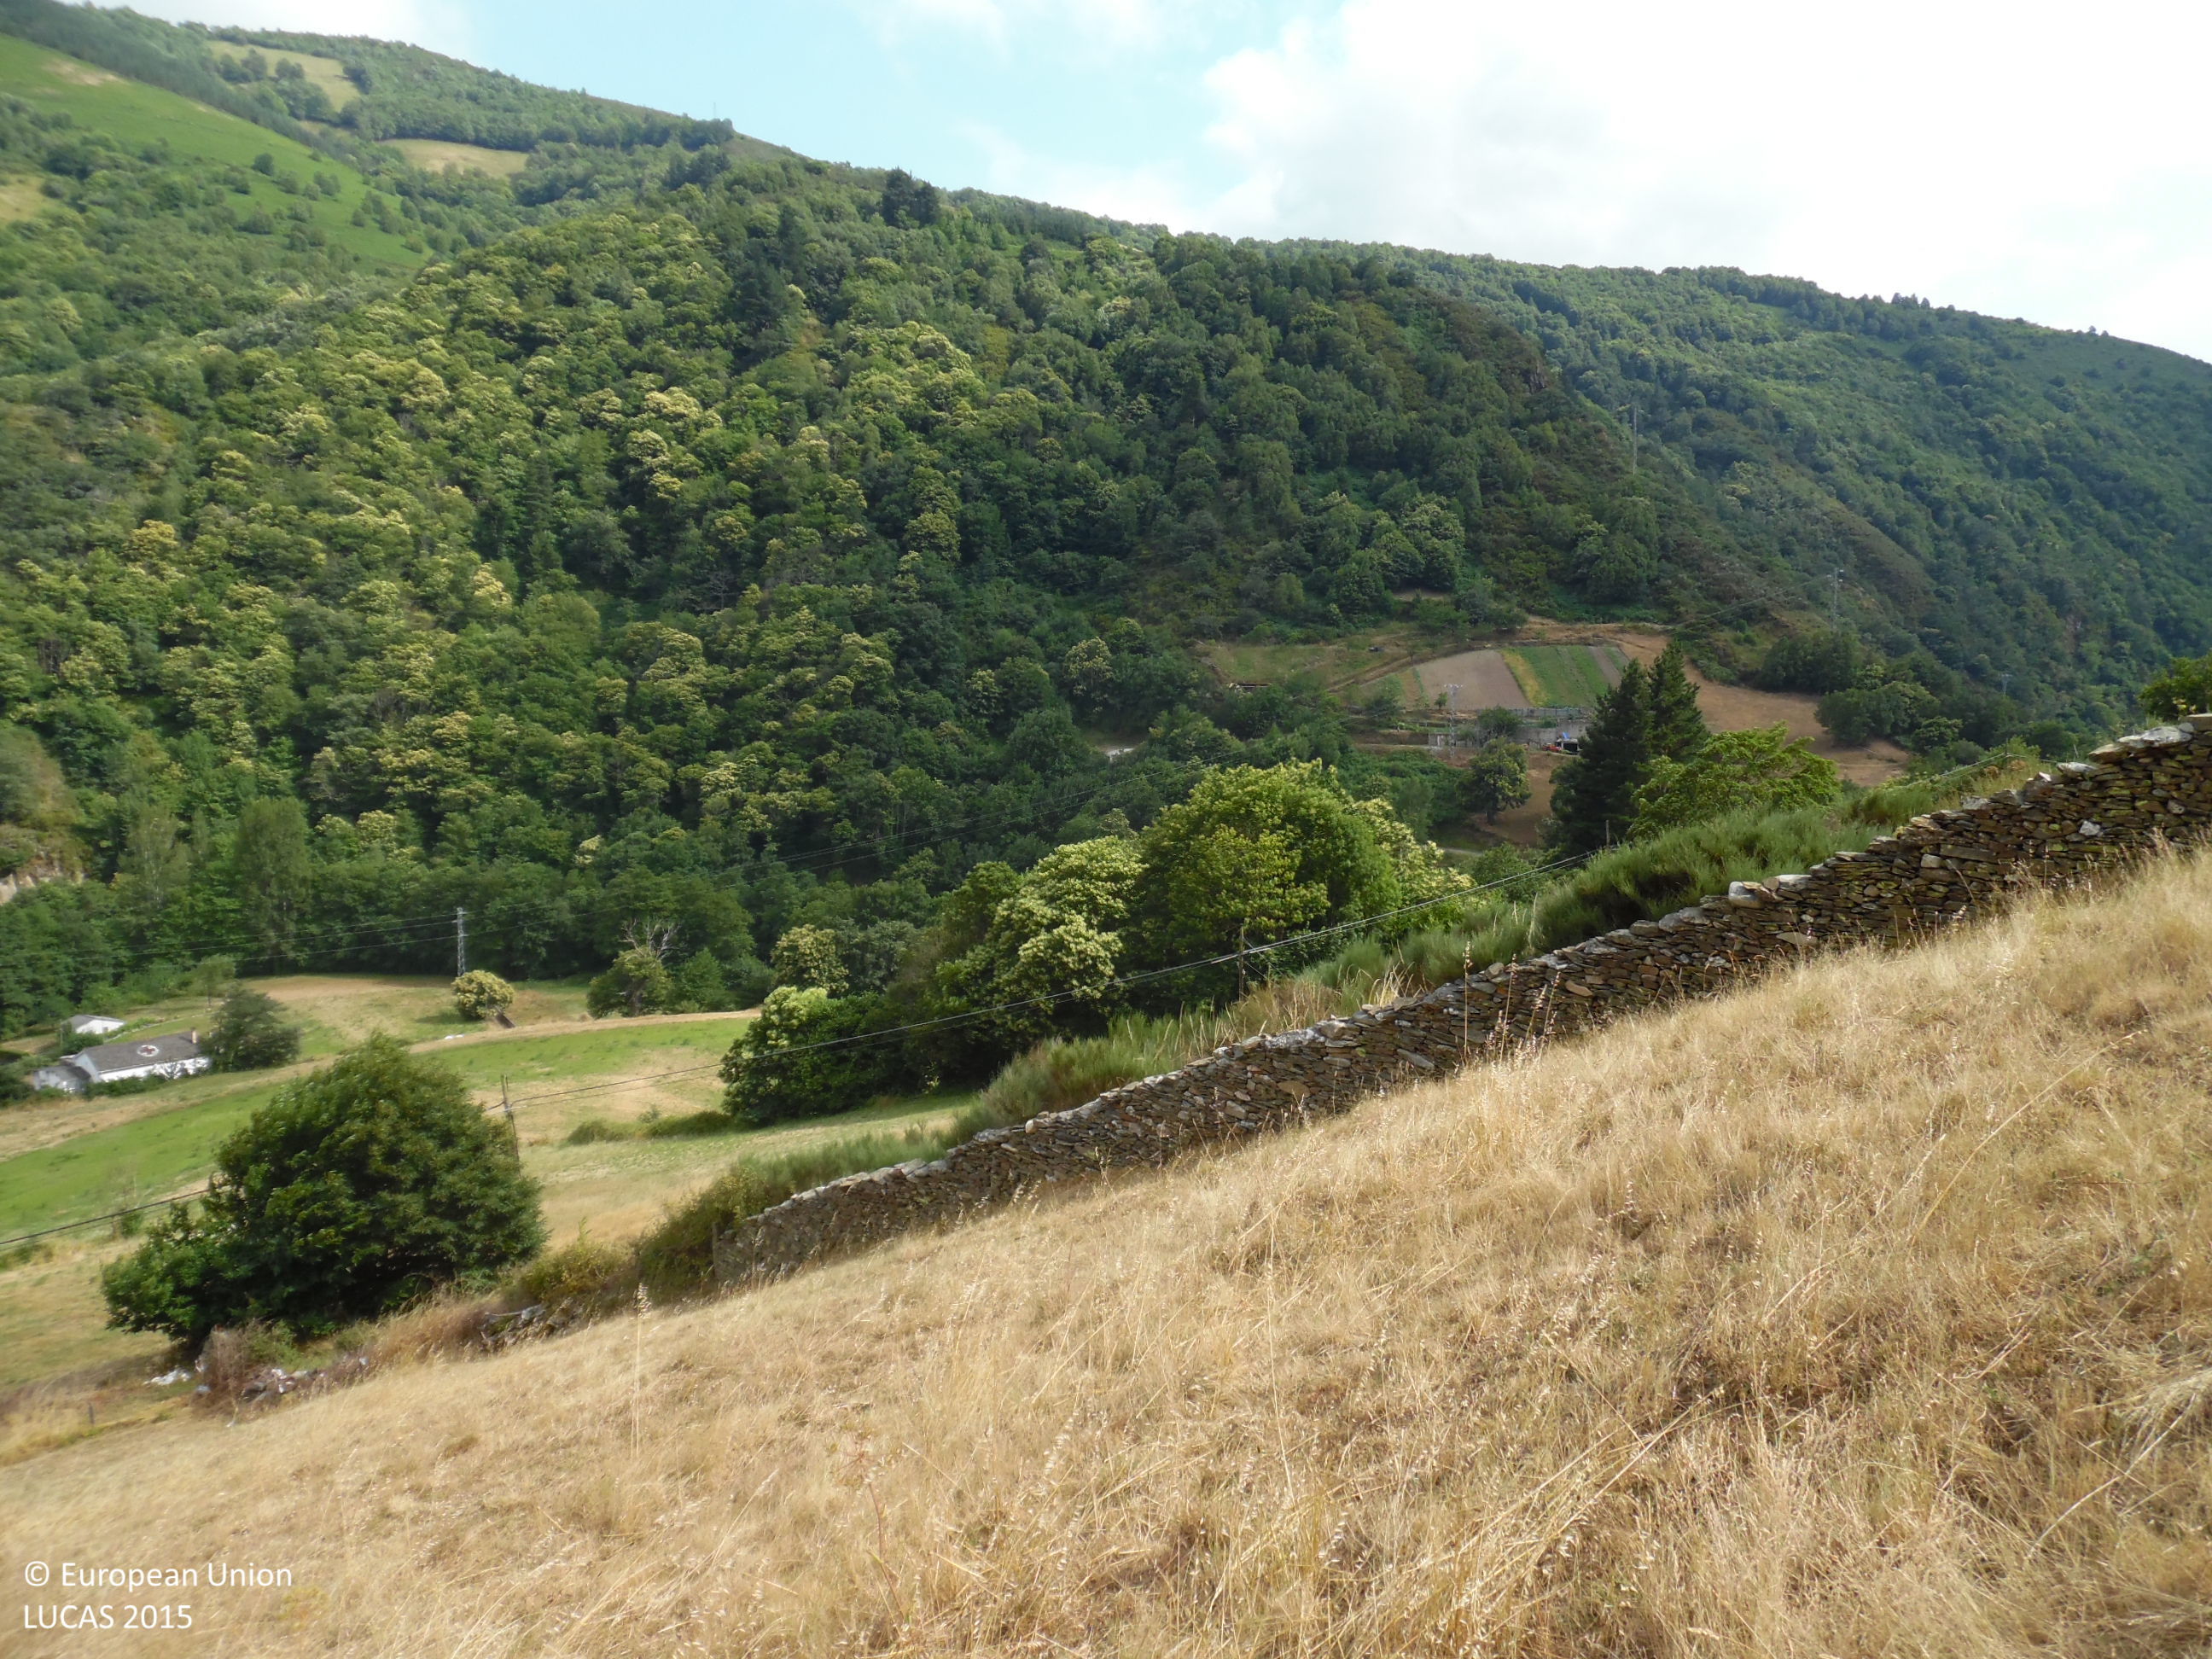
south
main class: Grassland
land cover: Grassland without tree/shrub cover
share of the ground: > 75 %
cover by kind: herbaceous plants 95 %, shrubs 5 %
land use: Agriculture (excluding fallow land and kitchen gardens)
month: July
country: ES
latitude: 43.1544
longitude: -6.5686
